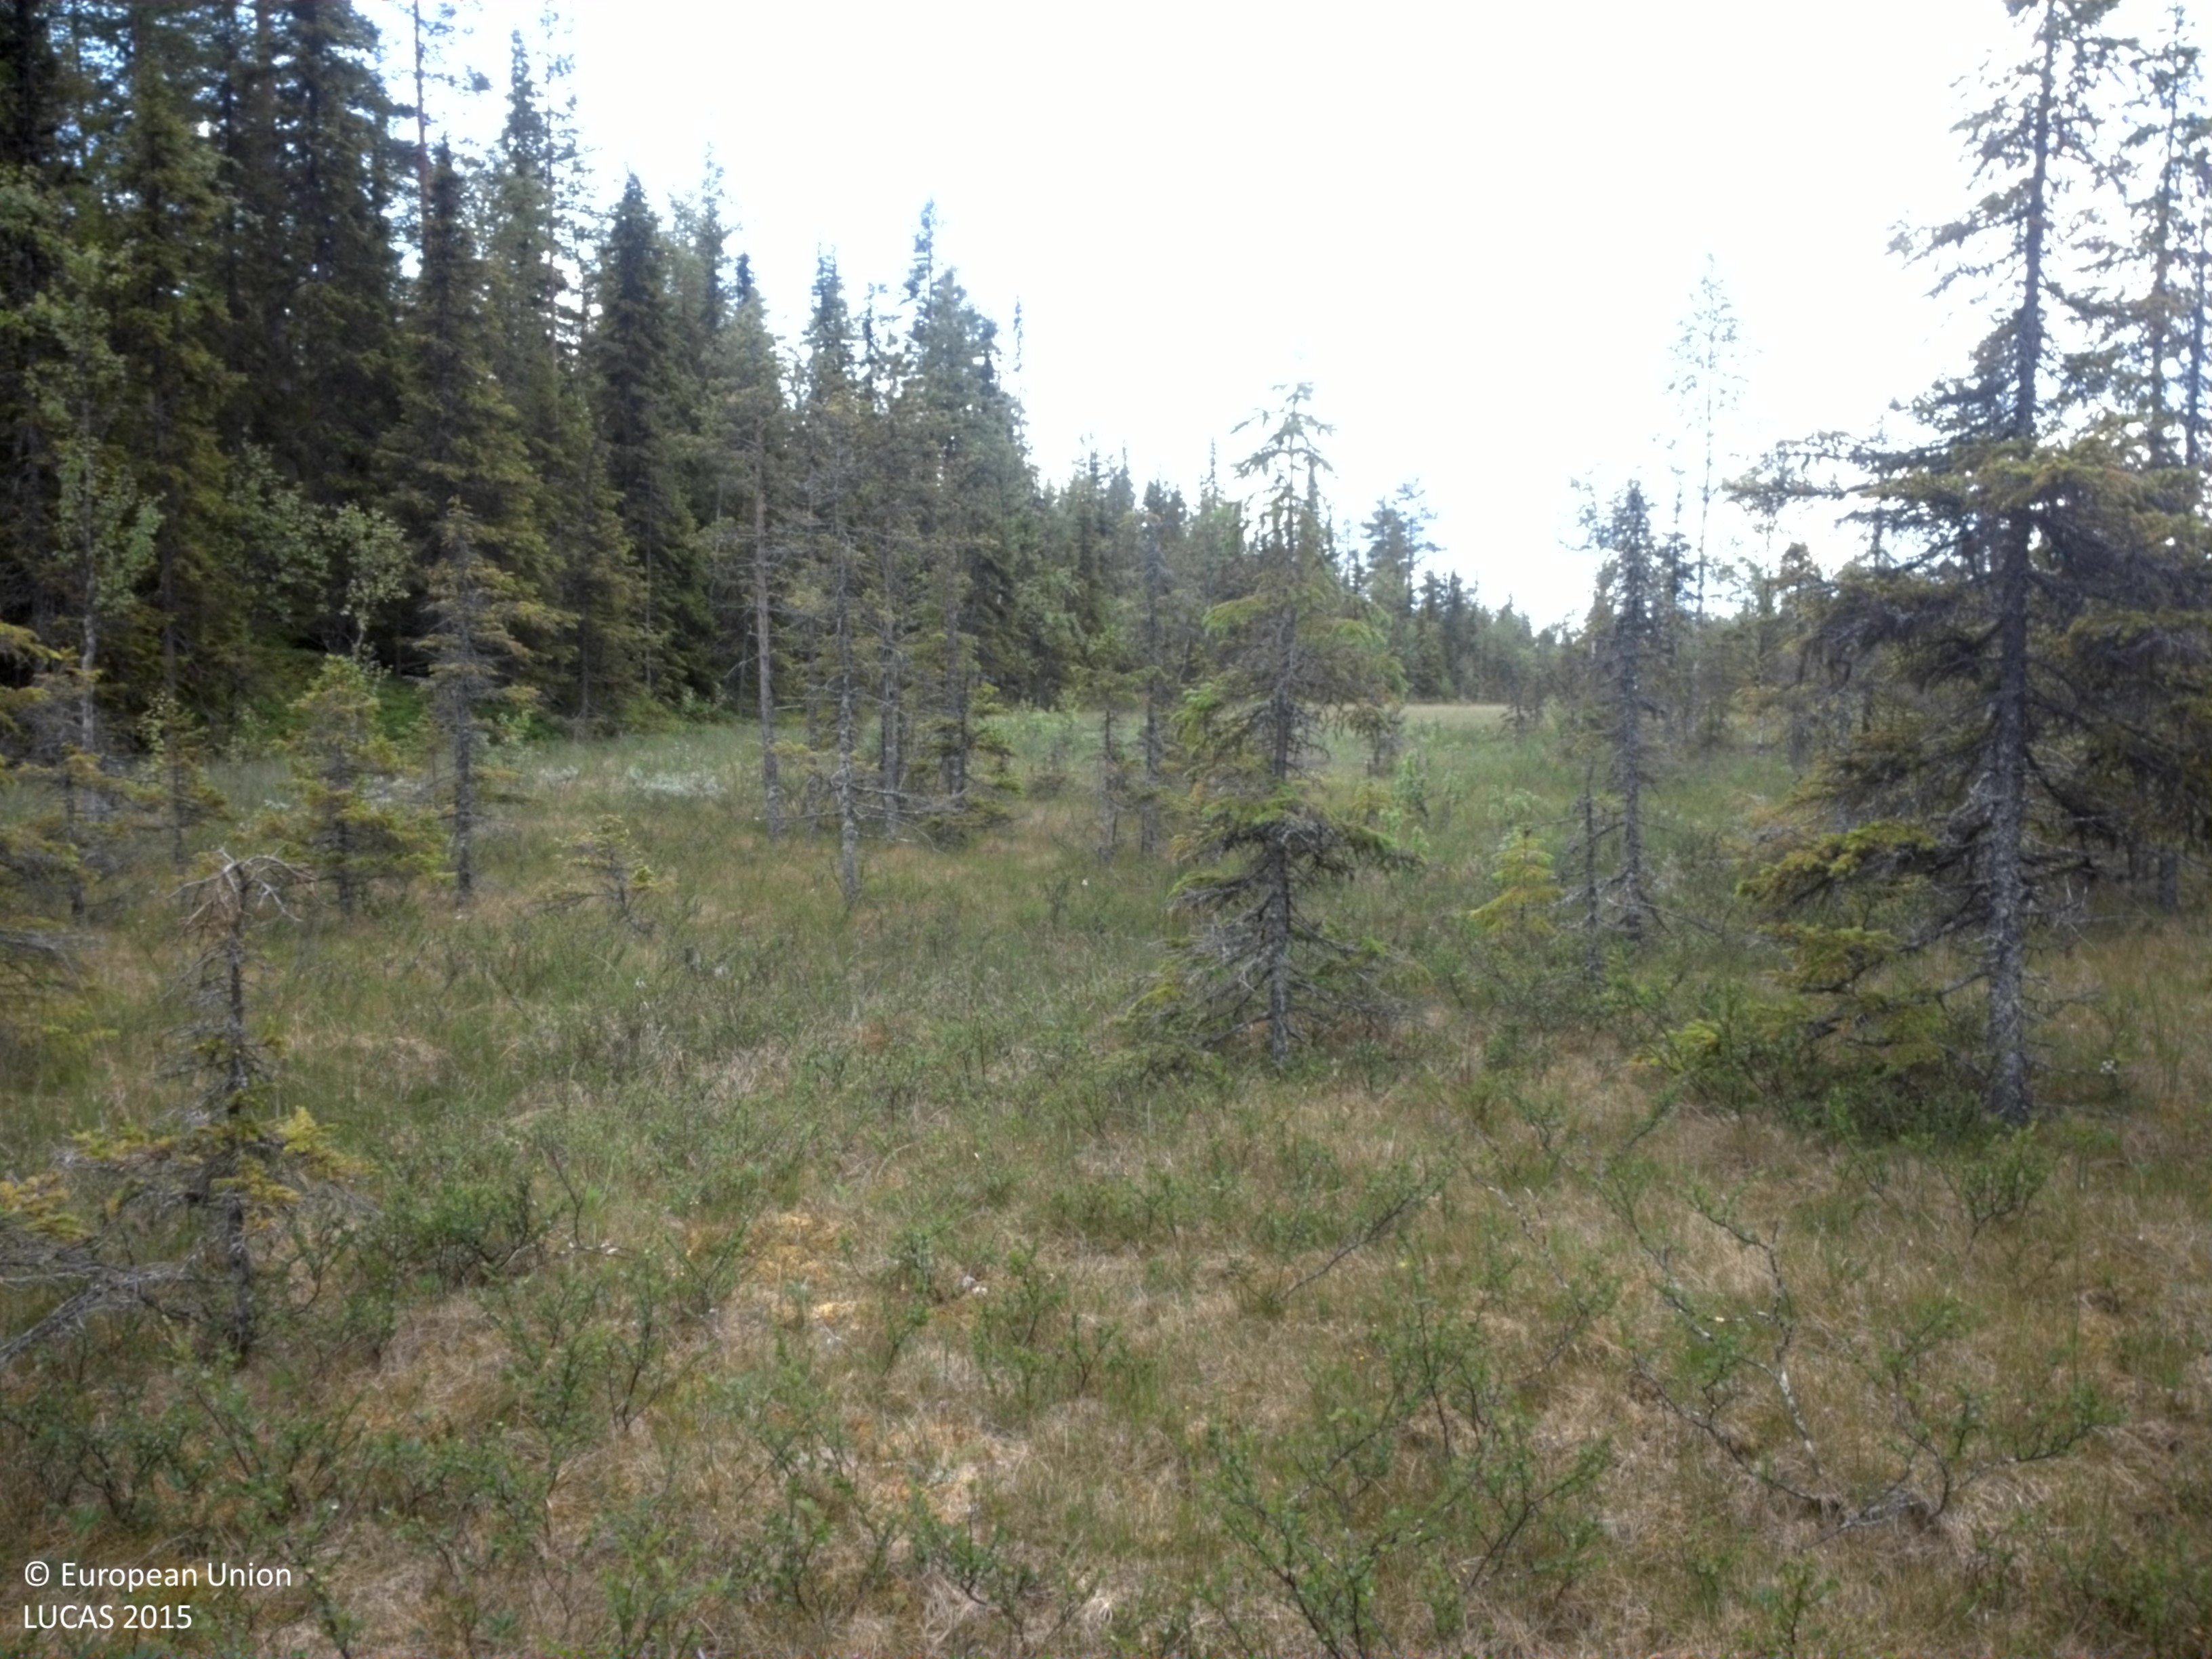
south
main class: Woodland
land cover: Spruce dominated coniferous woodland
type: mire and swamp forests
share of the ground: 10 - 25 %
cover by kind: coniferous forest trees 50 %, shrubs 25 %, herbaceous plants 25 %
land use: Forestry
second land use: Amenities, museums, leisure
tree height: < 5 m
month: July
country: SE
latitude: 64.4754
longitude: 18.2255
